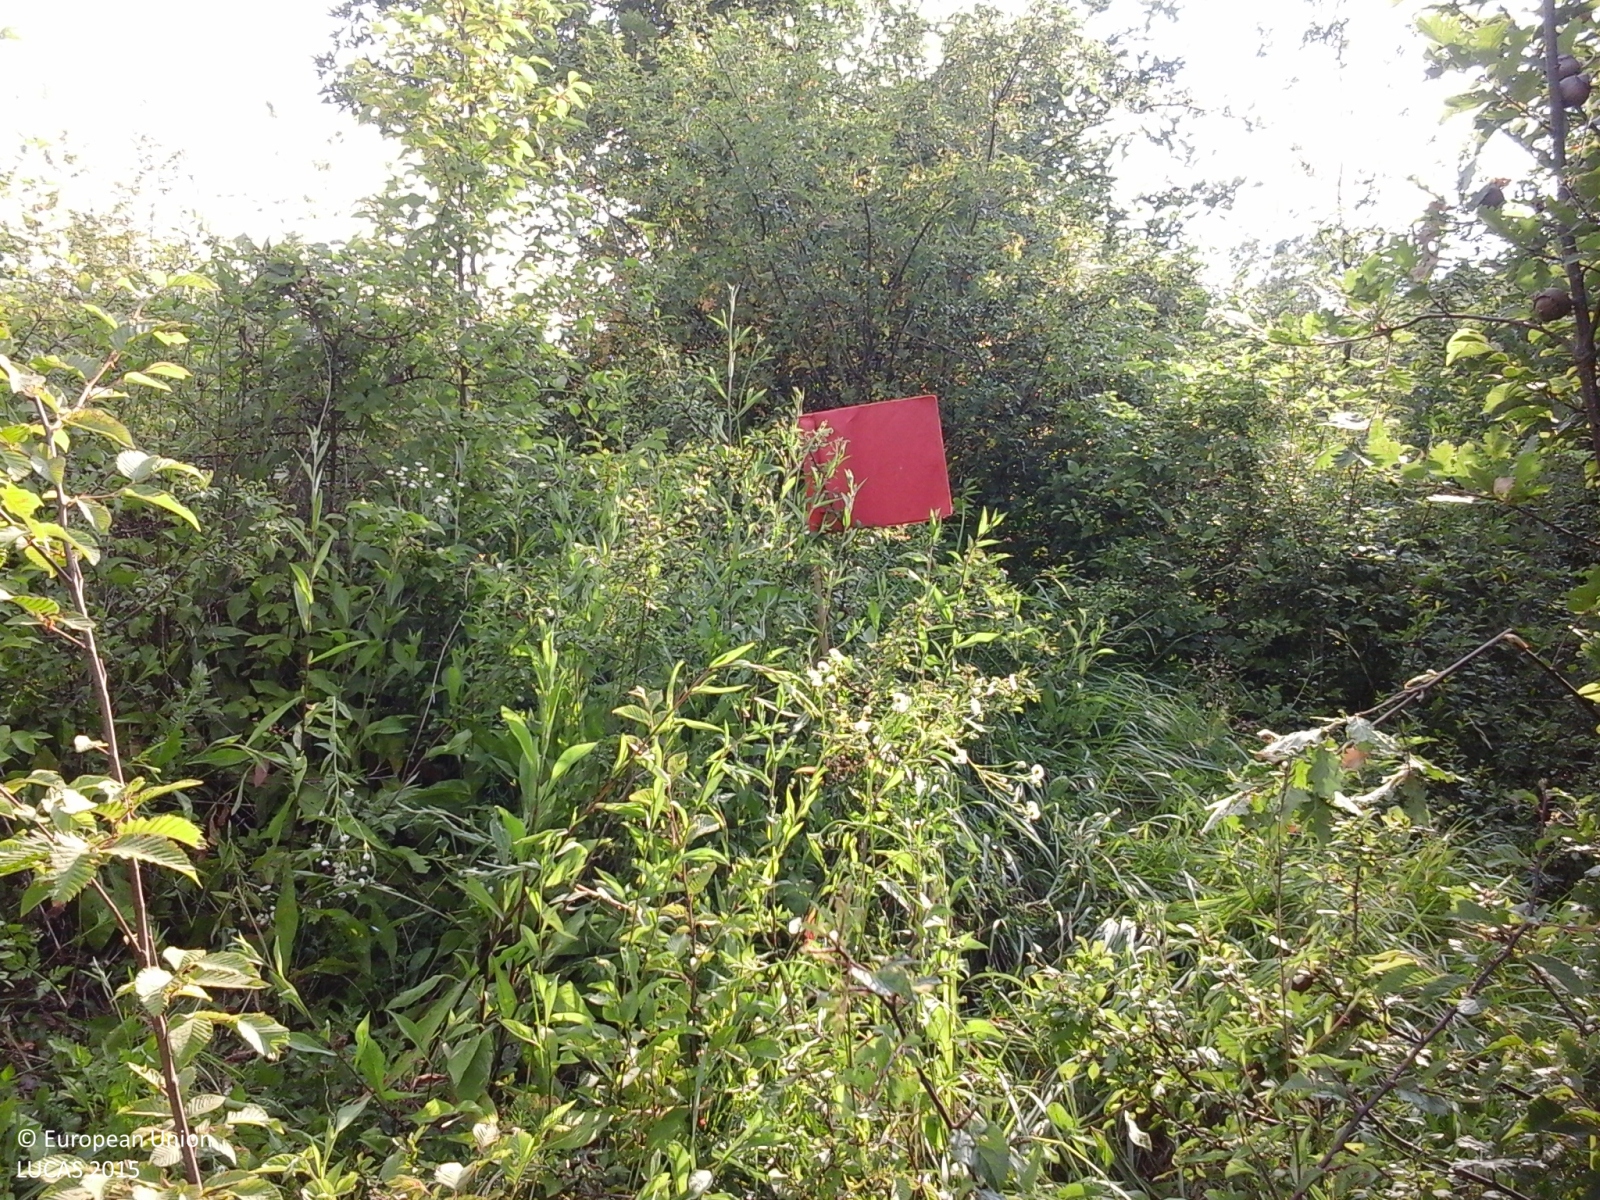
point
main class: Woodland
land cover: Broadleaved woodland
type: thermophilous deciduous forest
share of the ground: > 75 %
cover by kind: broadleaved forest trees 75 %, herbaceous plants 15 %, shrubs 10 %
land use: Agriculture (excluding fallow land and kitchen gardens)
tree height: < 5 m
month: July
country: IT
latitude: 44.7615
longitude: 9.1049
